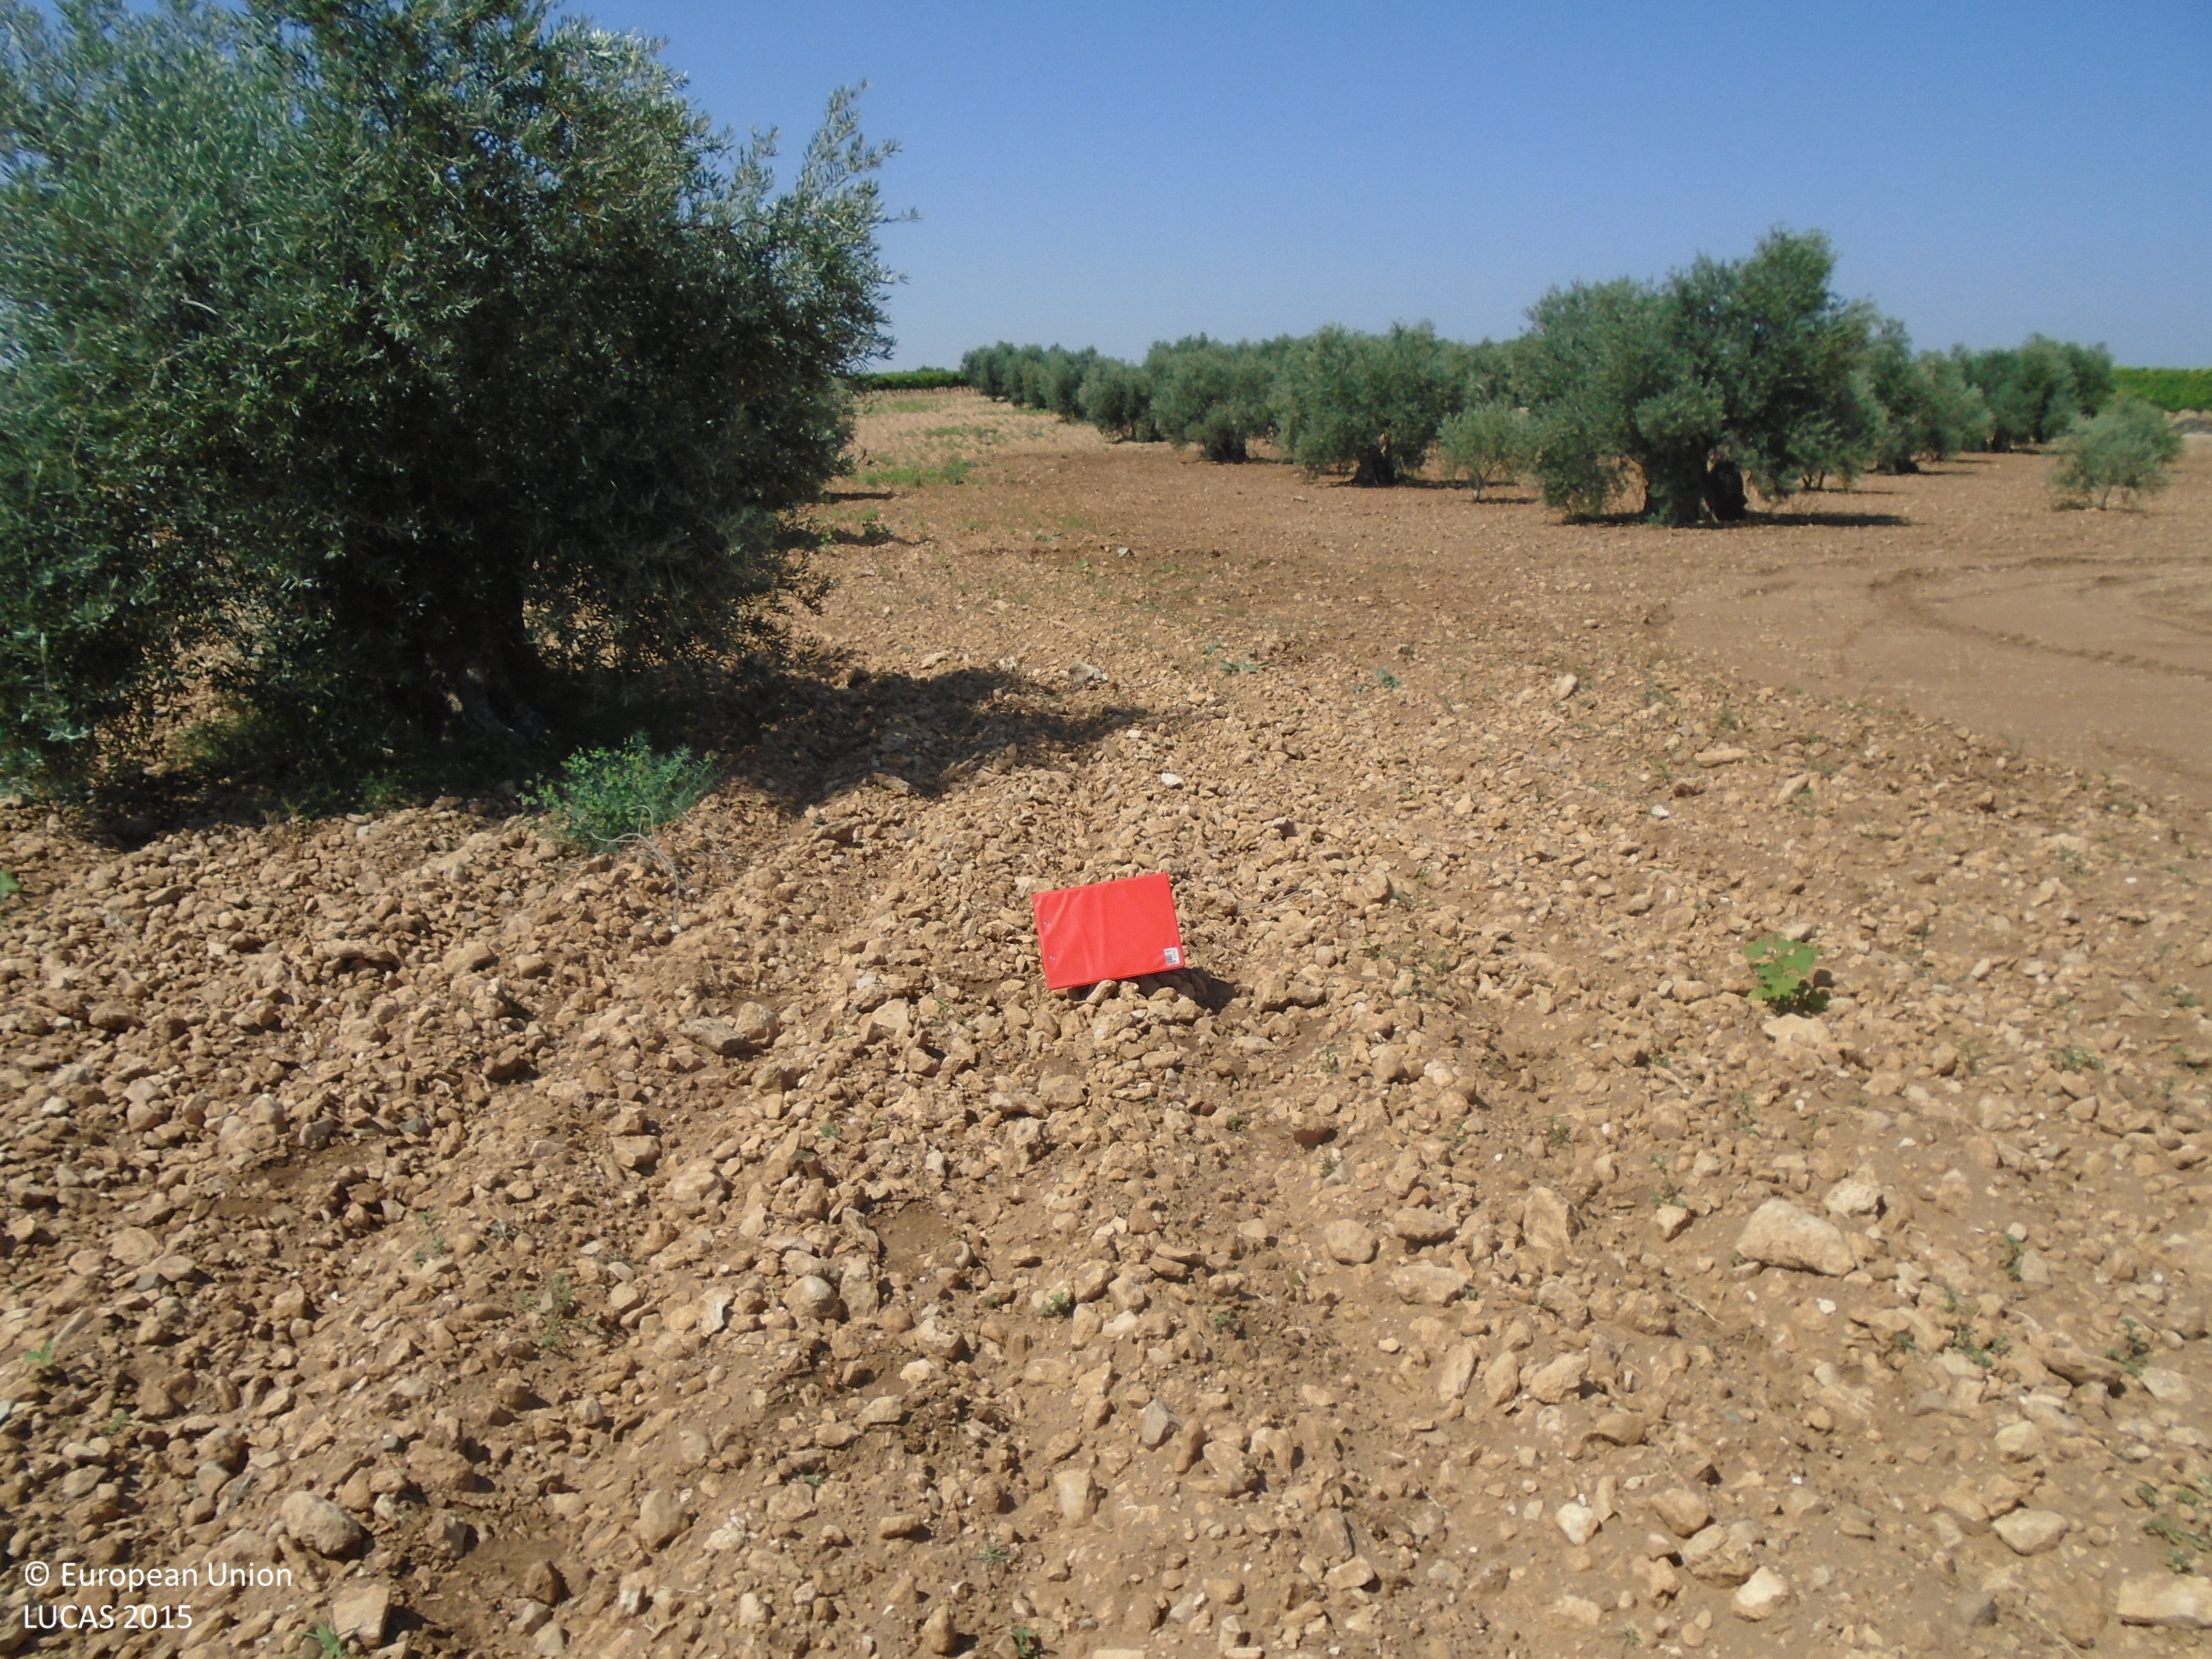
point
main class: Cropland
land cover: Olive groves
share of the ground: 10 - 25 %
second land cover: Other bare soil
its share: > 75 %
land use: Agriculture (excluding fallow land and kitchen gardens)
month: June
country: ES
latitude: 39.1630
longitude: -3.6414
